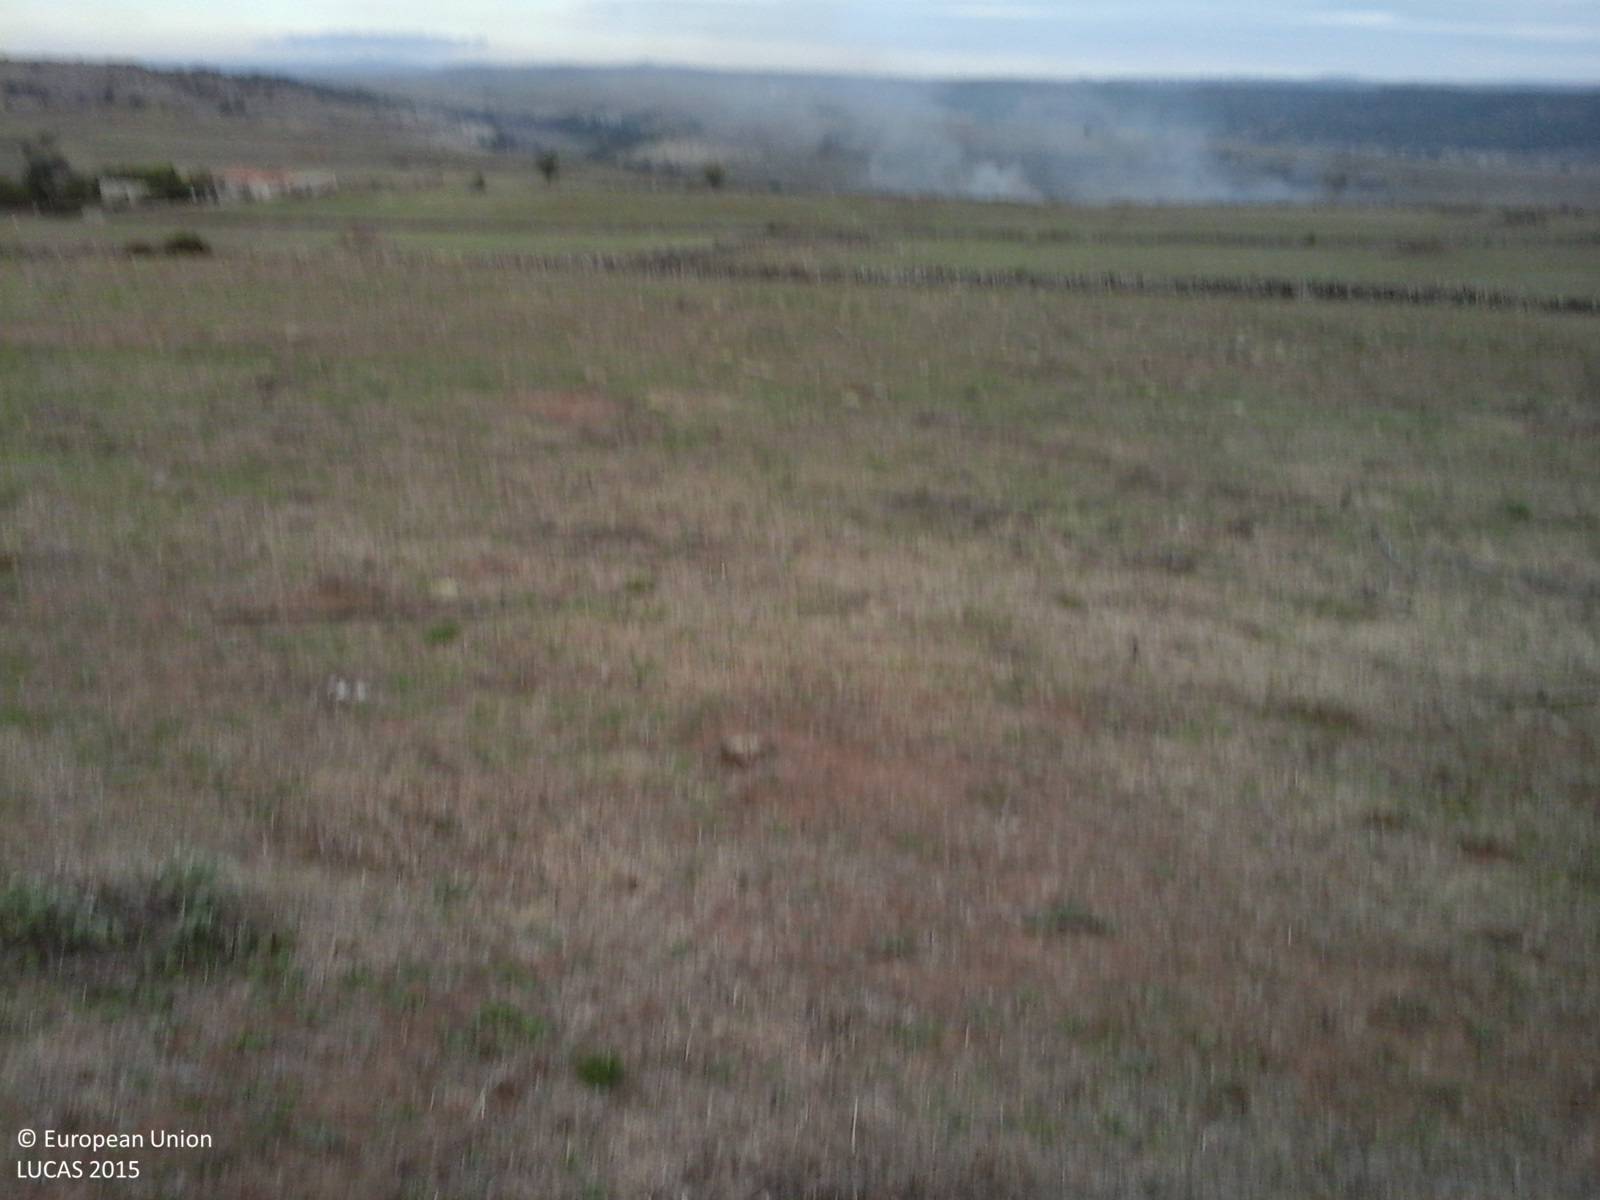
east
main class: Grassland
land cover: Grassland without tree/shrub cover
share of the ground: > 75 %
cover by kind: herbaceous plants 100 %
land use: Agriculture (excluding fallow land and kitchen gardens)
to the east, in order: Grassland without tree/shrub cover; Dry stone walls; Fences; Grassland without tree/shrub cover; Dry stone walls; Grassland without tree/shrub cover; Dry stone walls; Grassland without tree/shrub cover
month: October
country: IT
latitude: 40.4032
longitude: 8.6753
